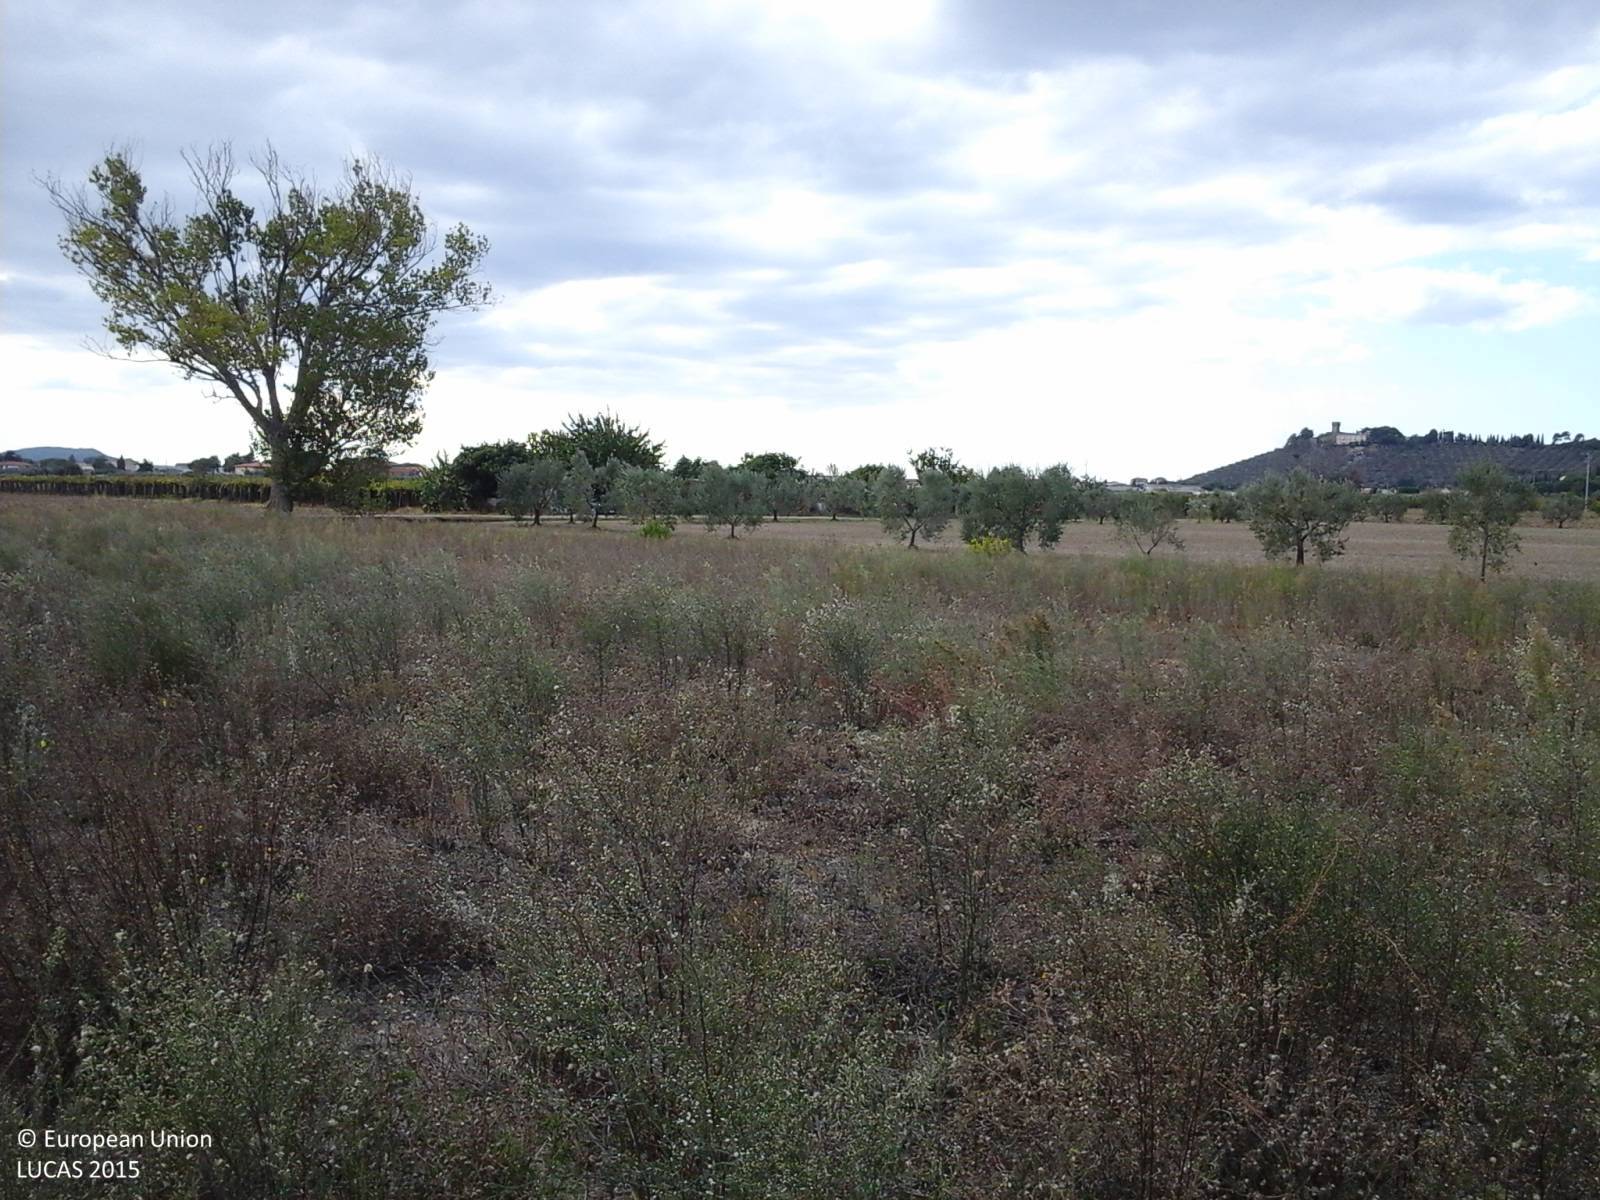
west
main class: Grassland
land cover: Spontaneously vegetated surfaces
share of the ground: > 75 %
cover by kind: herbaceous plants 100 %
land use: Fallow land
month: September
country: IT
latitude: 43.0313
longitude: 10.6240
